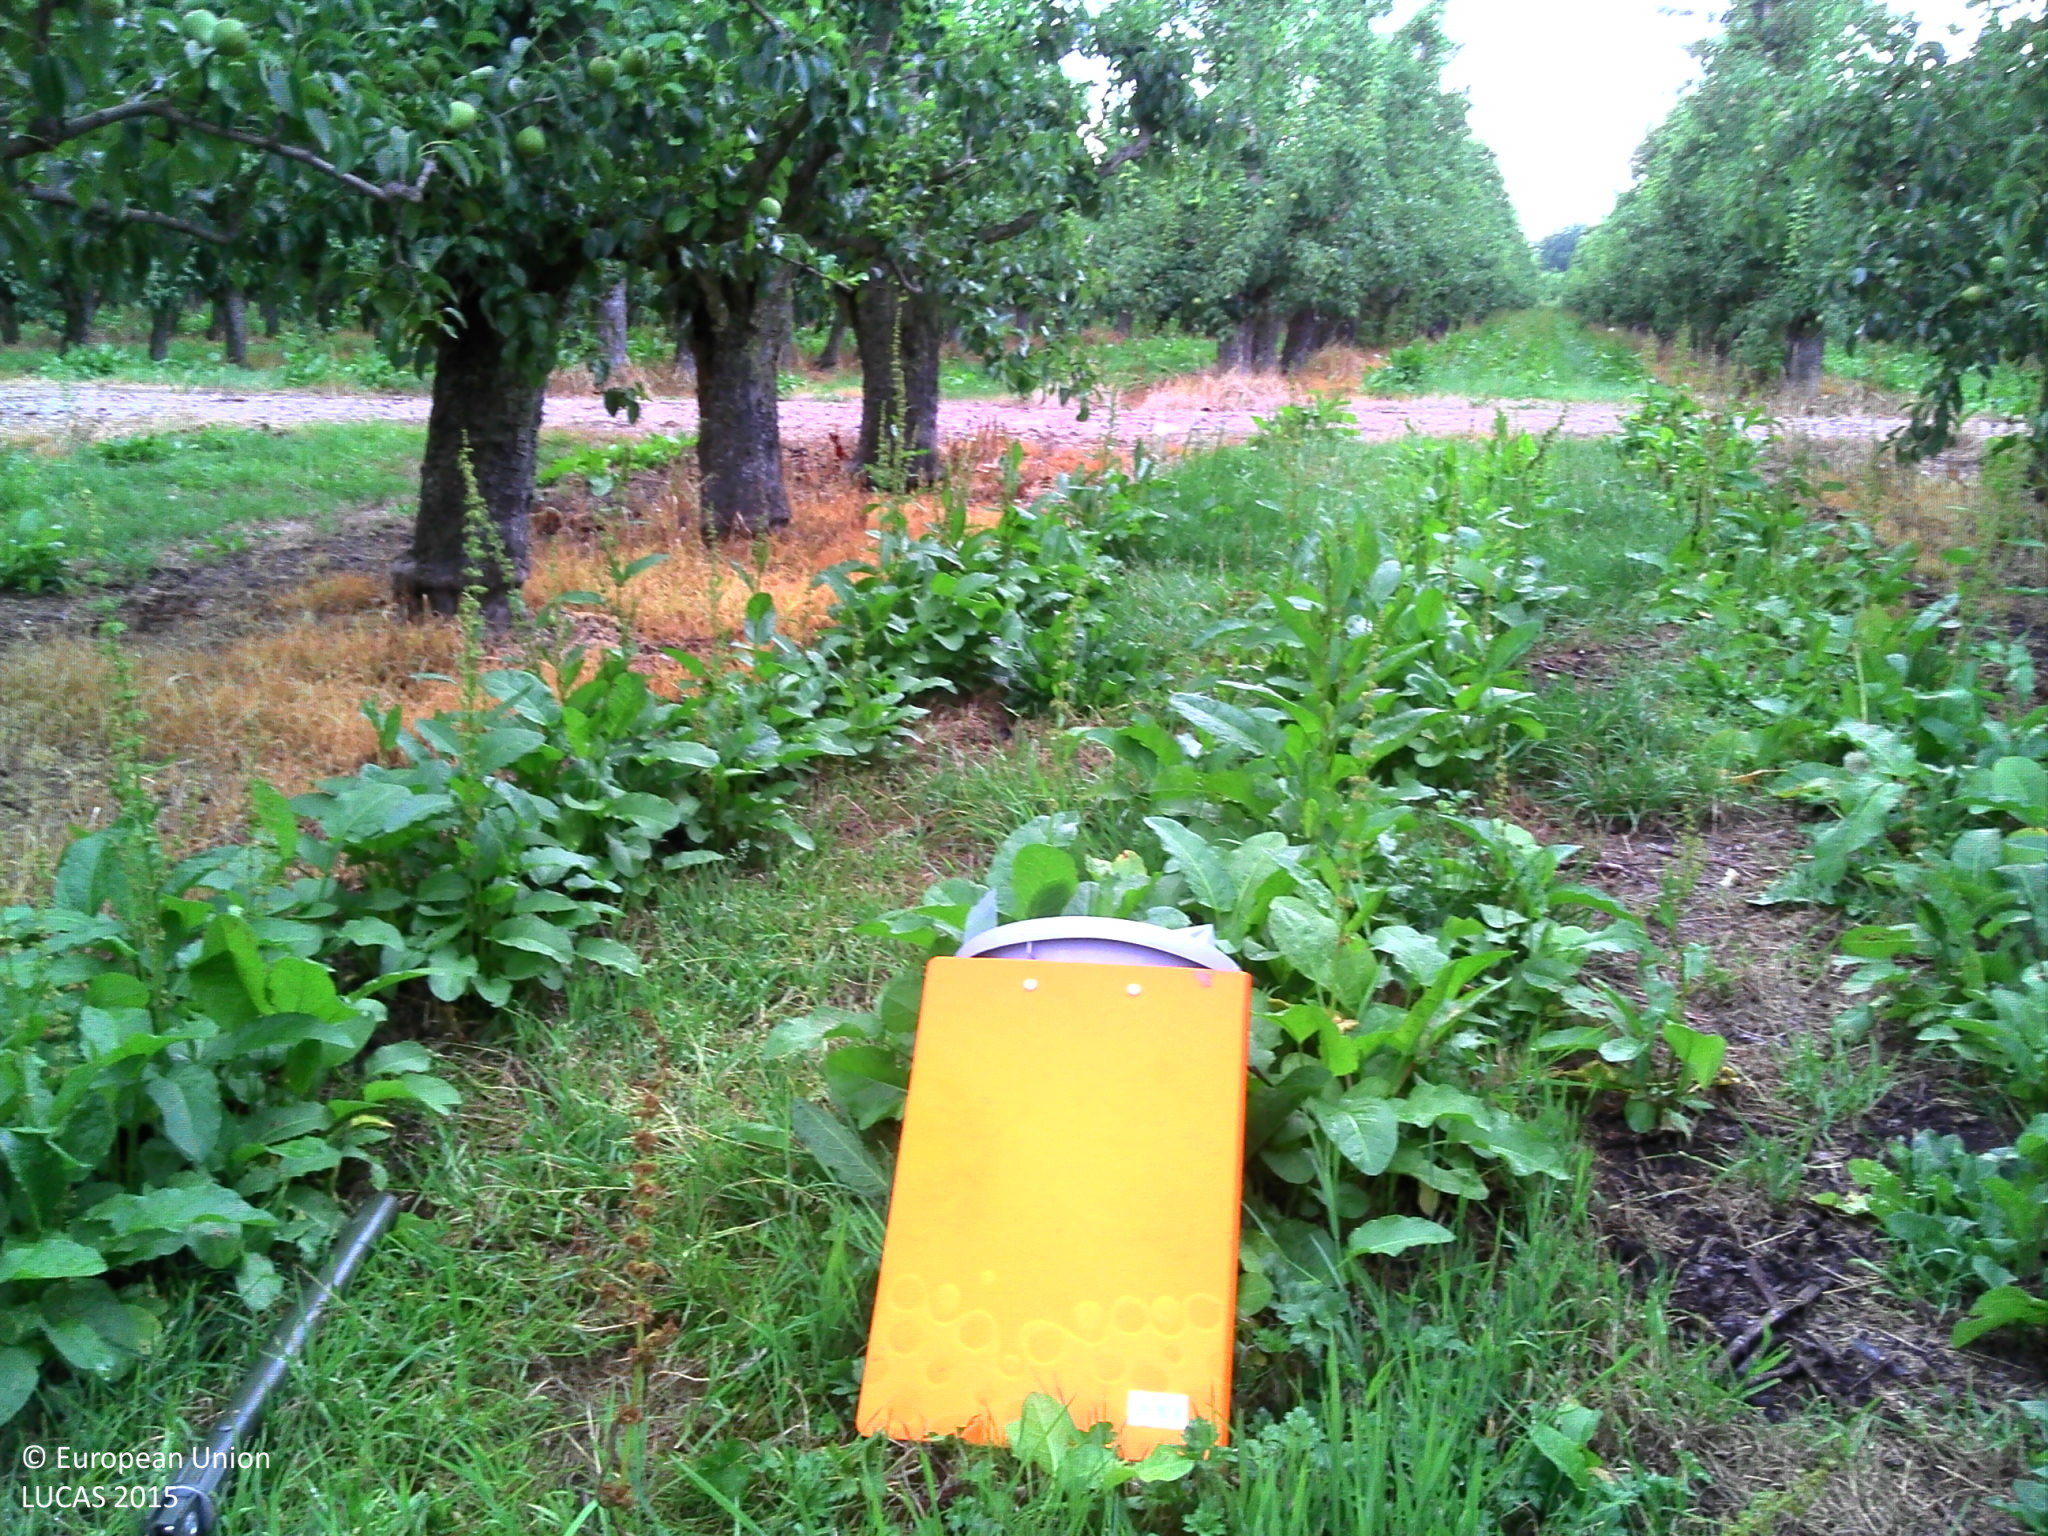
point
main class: Cropland
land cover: Pear fruit
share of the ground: 50 - 75 %
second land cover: Spontaneously vegetated surfaces
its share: 25 - 50 %
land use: Agriculture (excluding fallow land and kitchen gardens)
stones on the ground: < 10 %
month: July
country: BE
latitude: 50.8737
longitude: 5.1515
